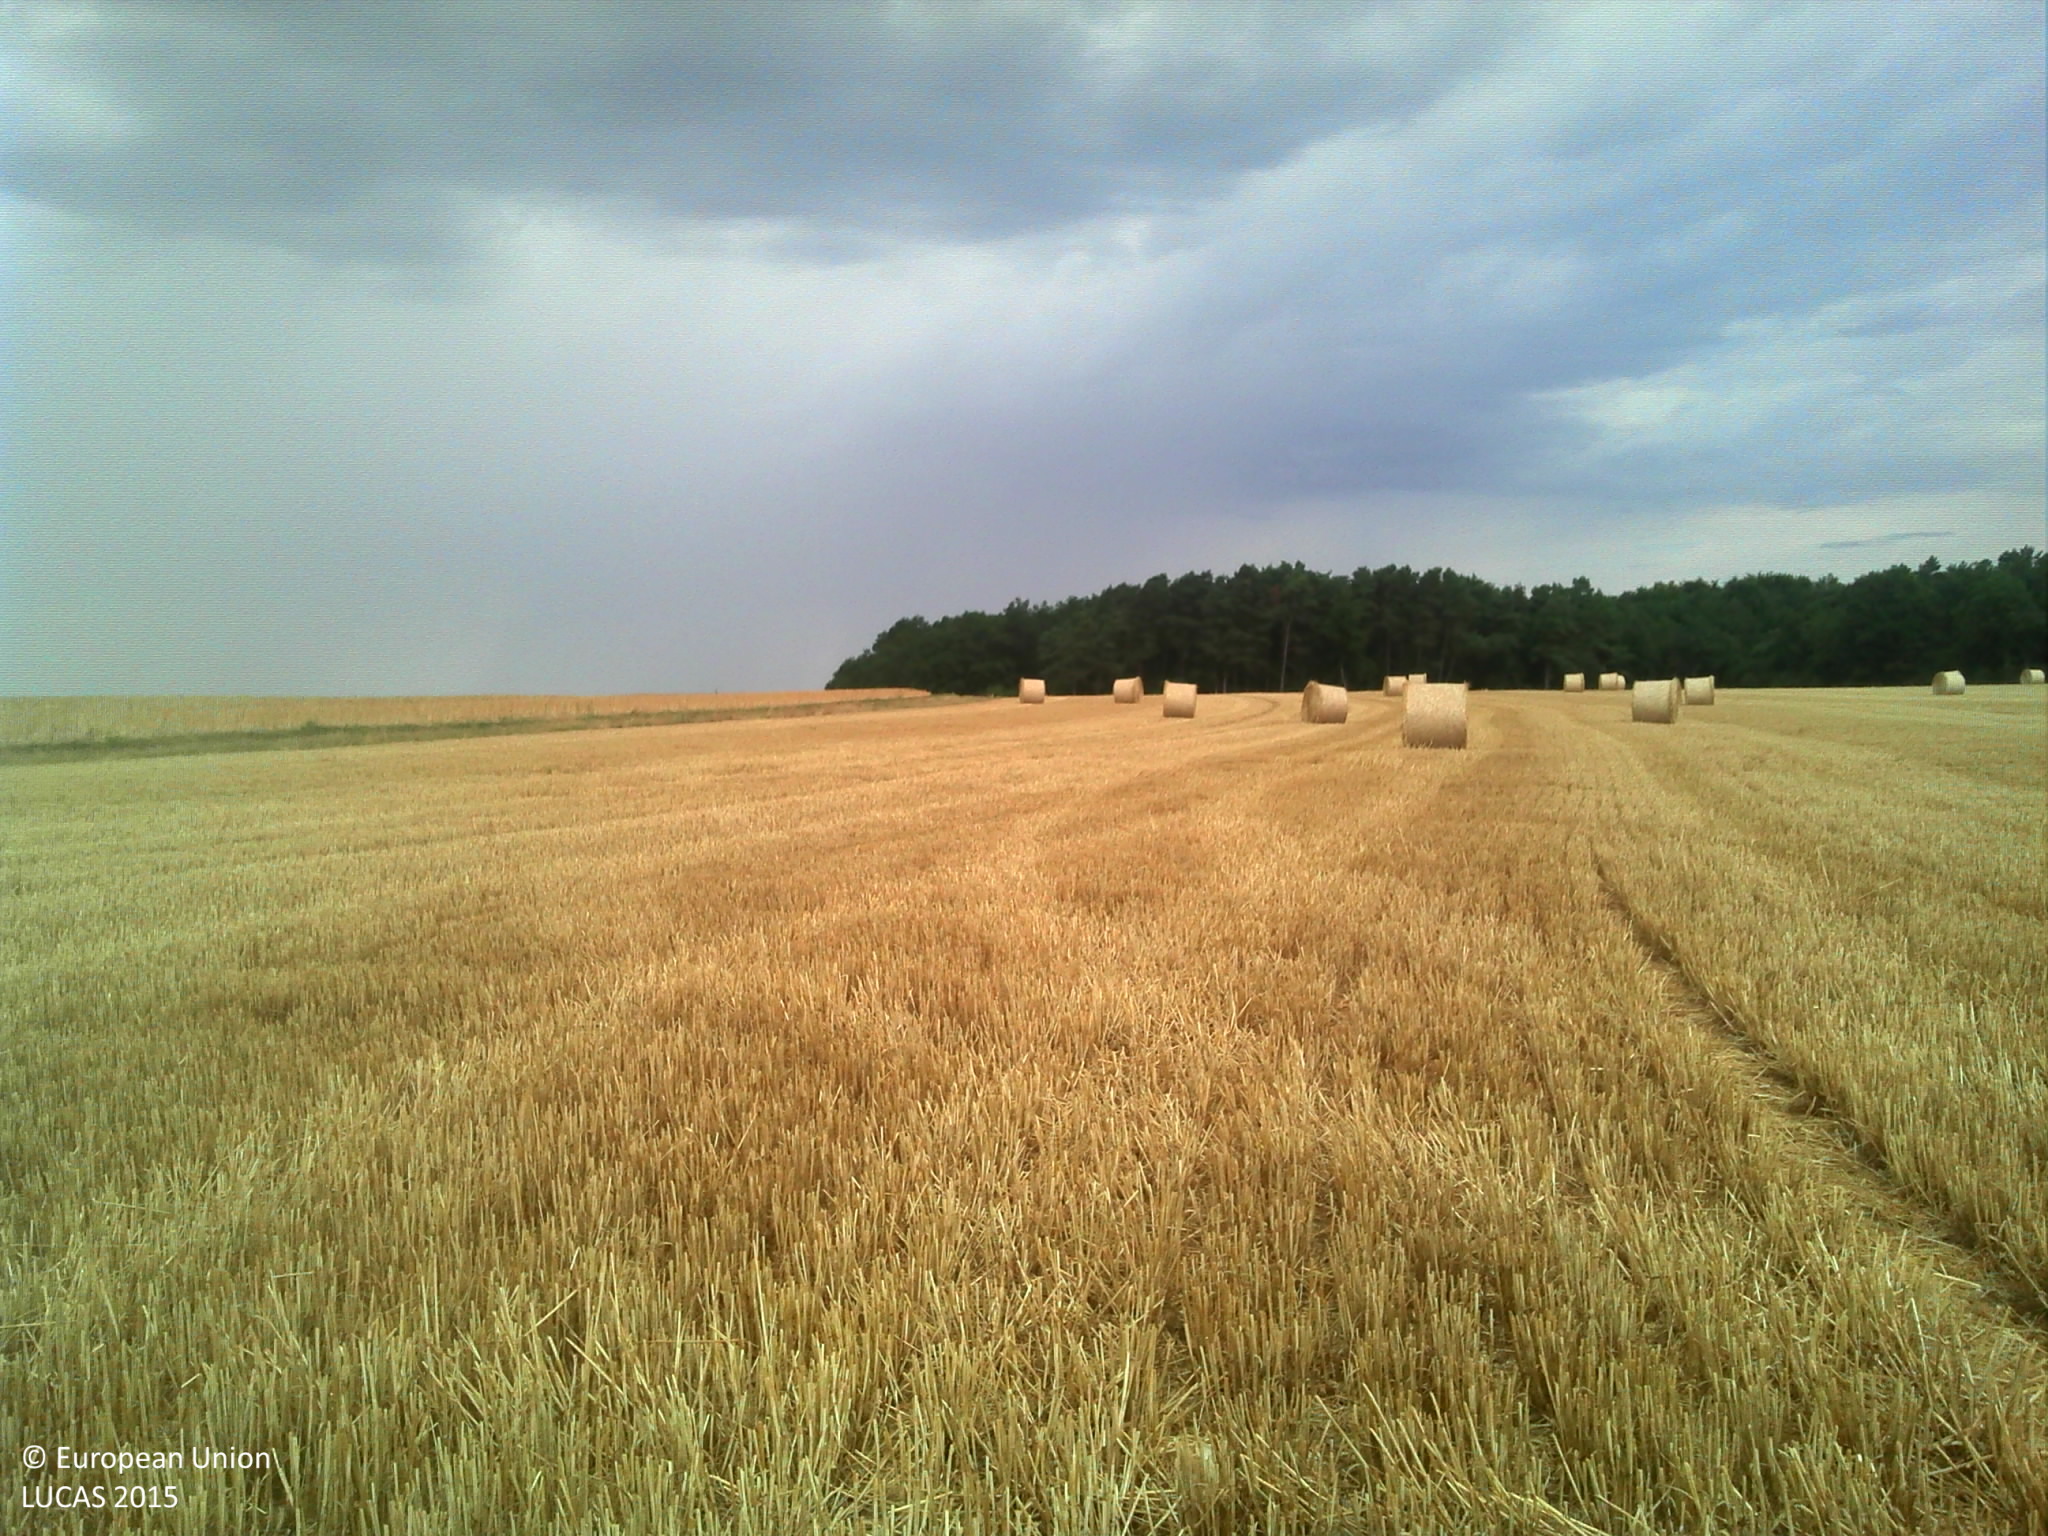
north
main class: Cropland
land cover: Common wheat
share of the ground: 10 - 25 %
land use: Agriculture (excluding fallow land and kitchen gardens)
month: July
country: FR
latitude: 47.9912
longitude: 5.1620
